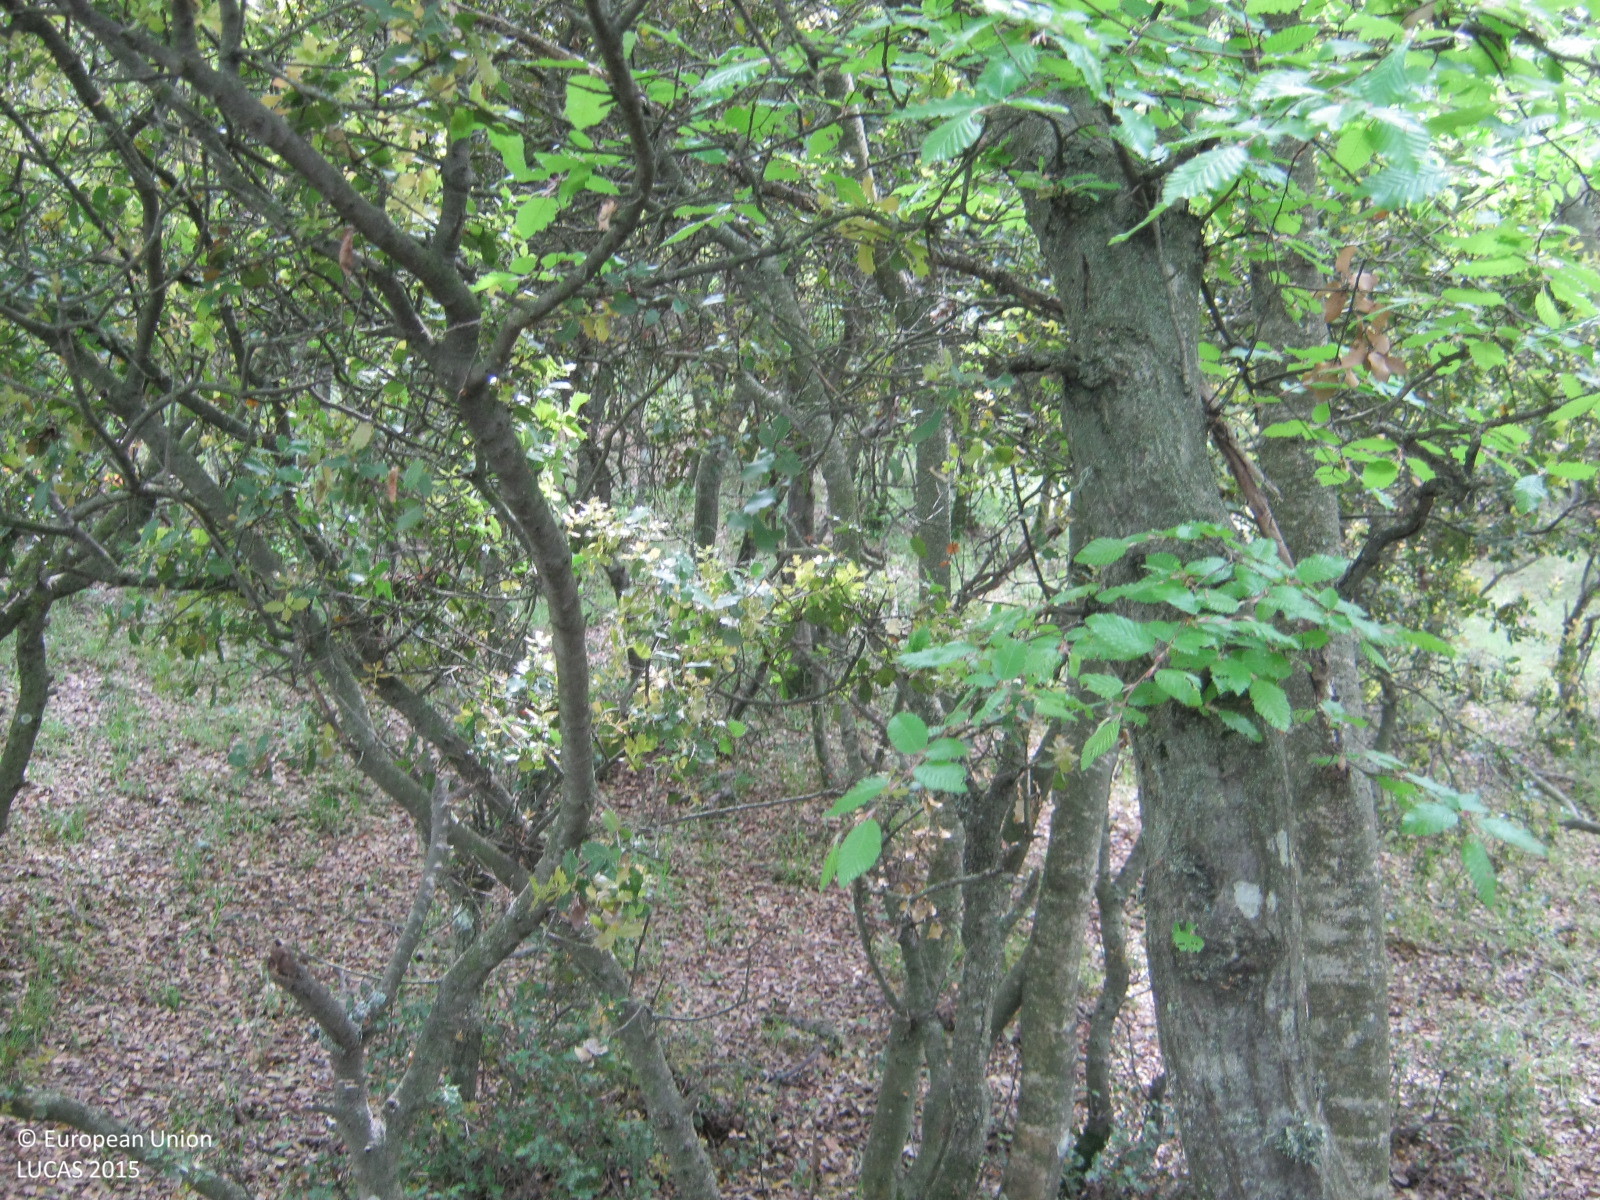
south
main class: Shrubland
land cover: Shrubland with sparse tree cover
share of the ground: > 75 %
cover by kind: shrubs 80 %, herbaceous plants 15 %, broadleaved forest trees 5 %
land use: Agriculture (excluding fallow land and kitchen gardens)
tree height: < 5 m
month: April
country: GR
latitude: 41.0438
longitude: 23.2804
